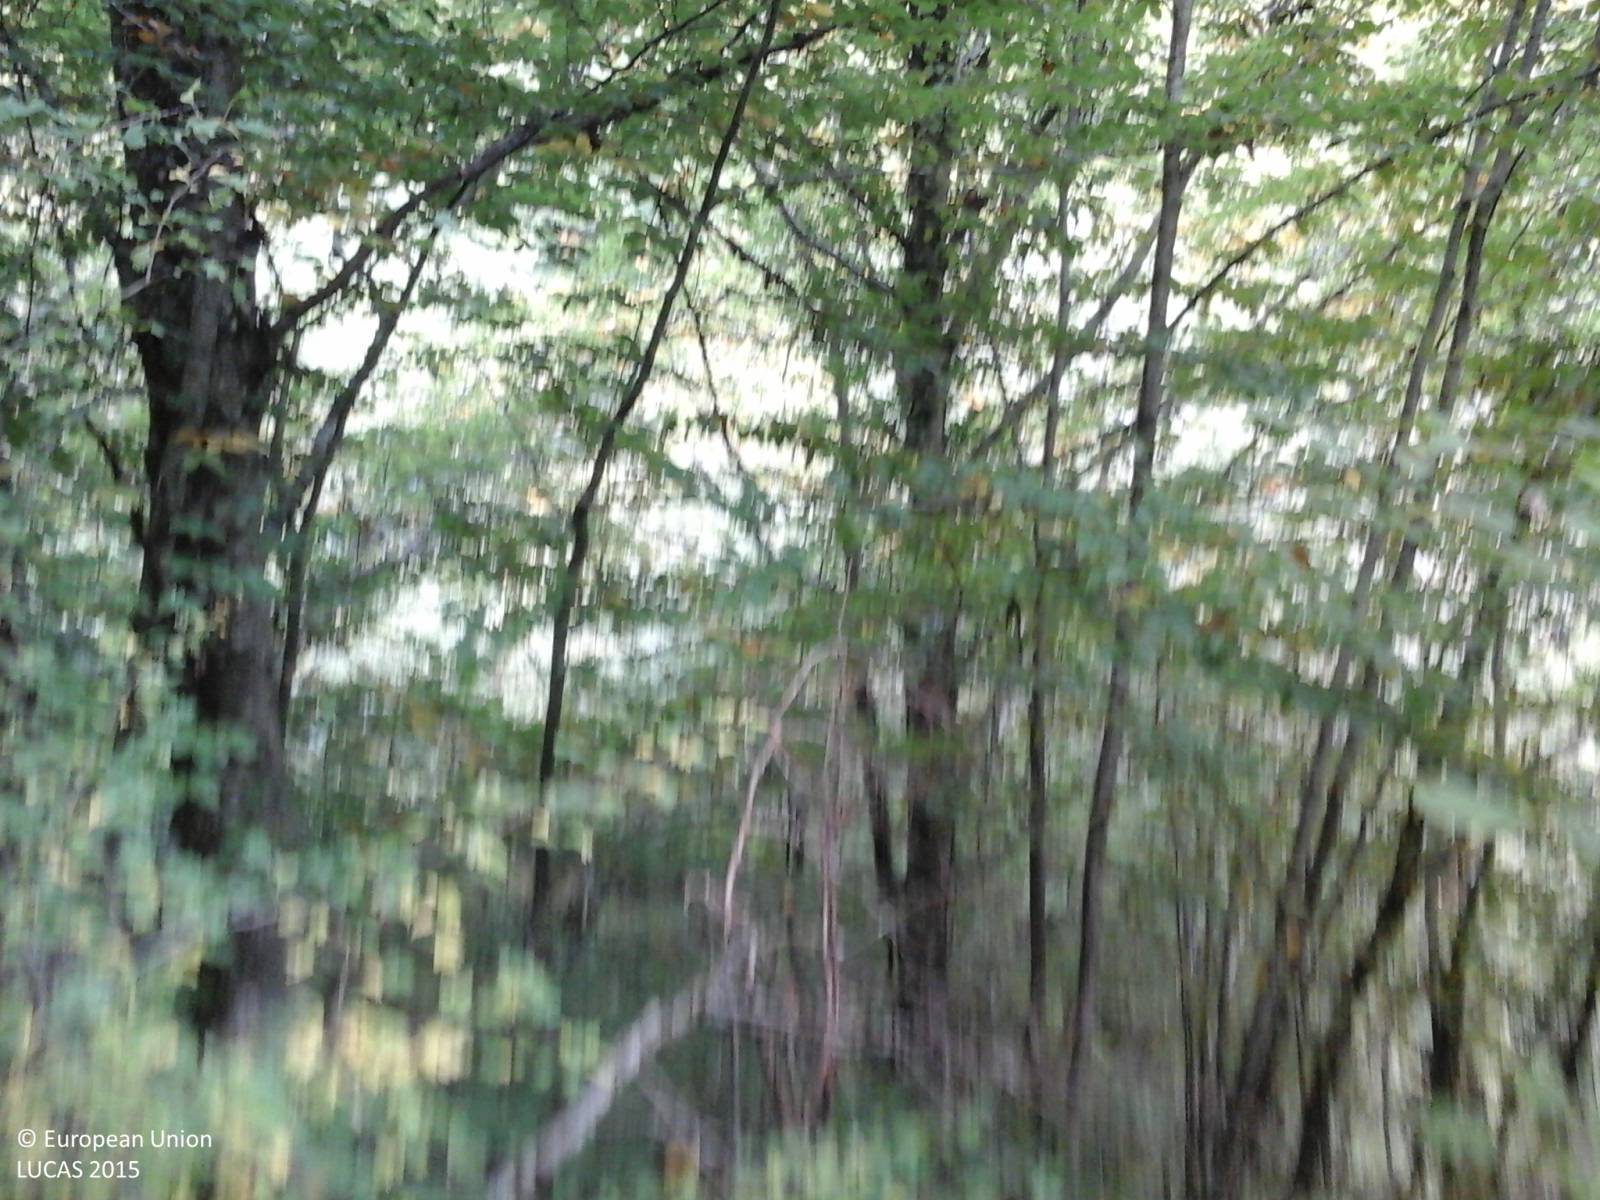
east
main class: Woodland
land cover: Broadleaved woodland
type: thermophilous deciduous forest
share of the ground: > 75 %
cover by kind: broadleaved forest trees 100 %
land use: Forestry
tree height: > 5 m
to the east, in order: Broadleaved woodland; Rivers and streams; Broadleaved woodland; Shrubland with sparse tree cover; Broadleaved woodland; Grassland without tree/shrub cover
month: October
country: IT
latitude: 42.5142
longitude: 13.1667
